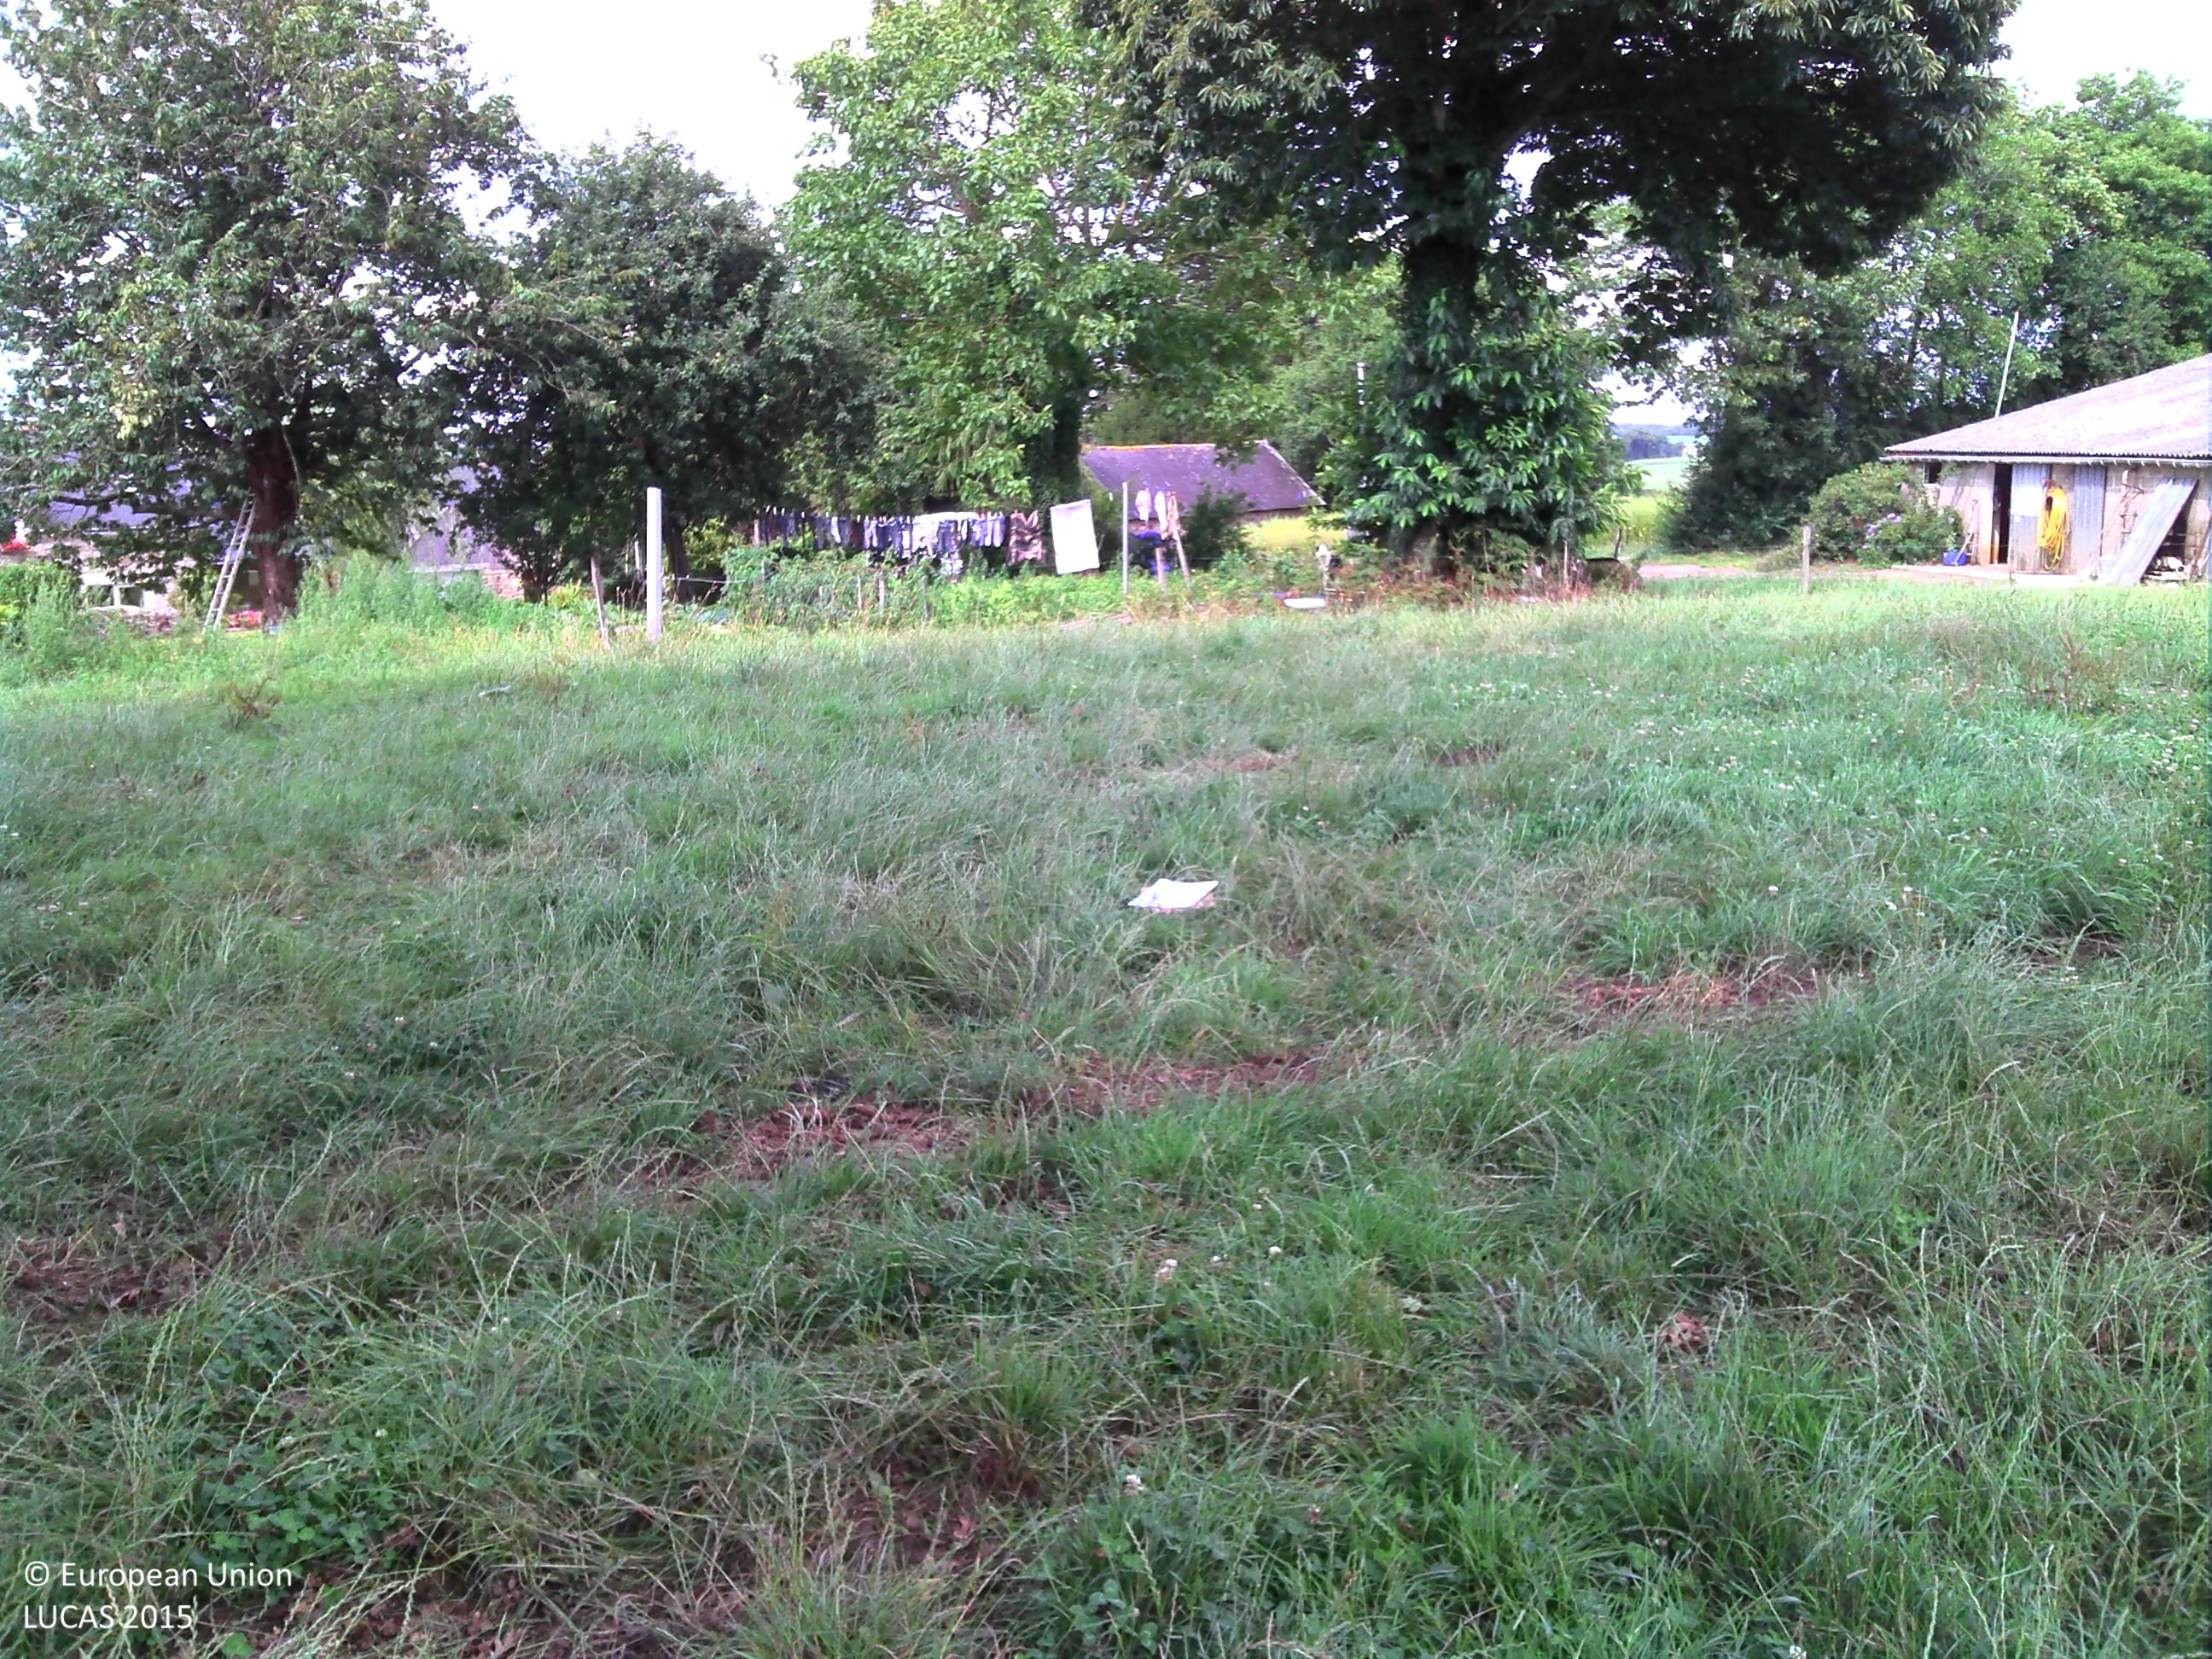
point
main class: Grassland
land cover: Grassland without tree/shrub cover
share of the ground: > 75 %
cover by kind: herbaceous plants 70 %, consolidated bare surface 30 %
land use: Agriculture (excluding fallow land and kitchen gardens)
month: July
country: FR
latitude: 47.9112
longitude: -2.9511
